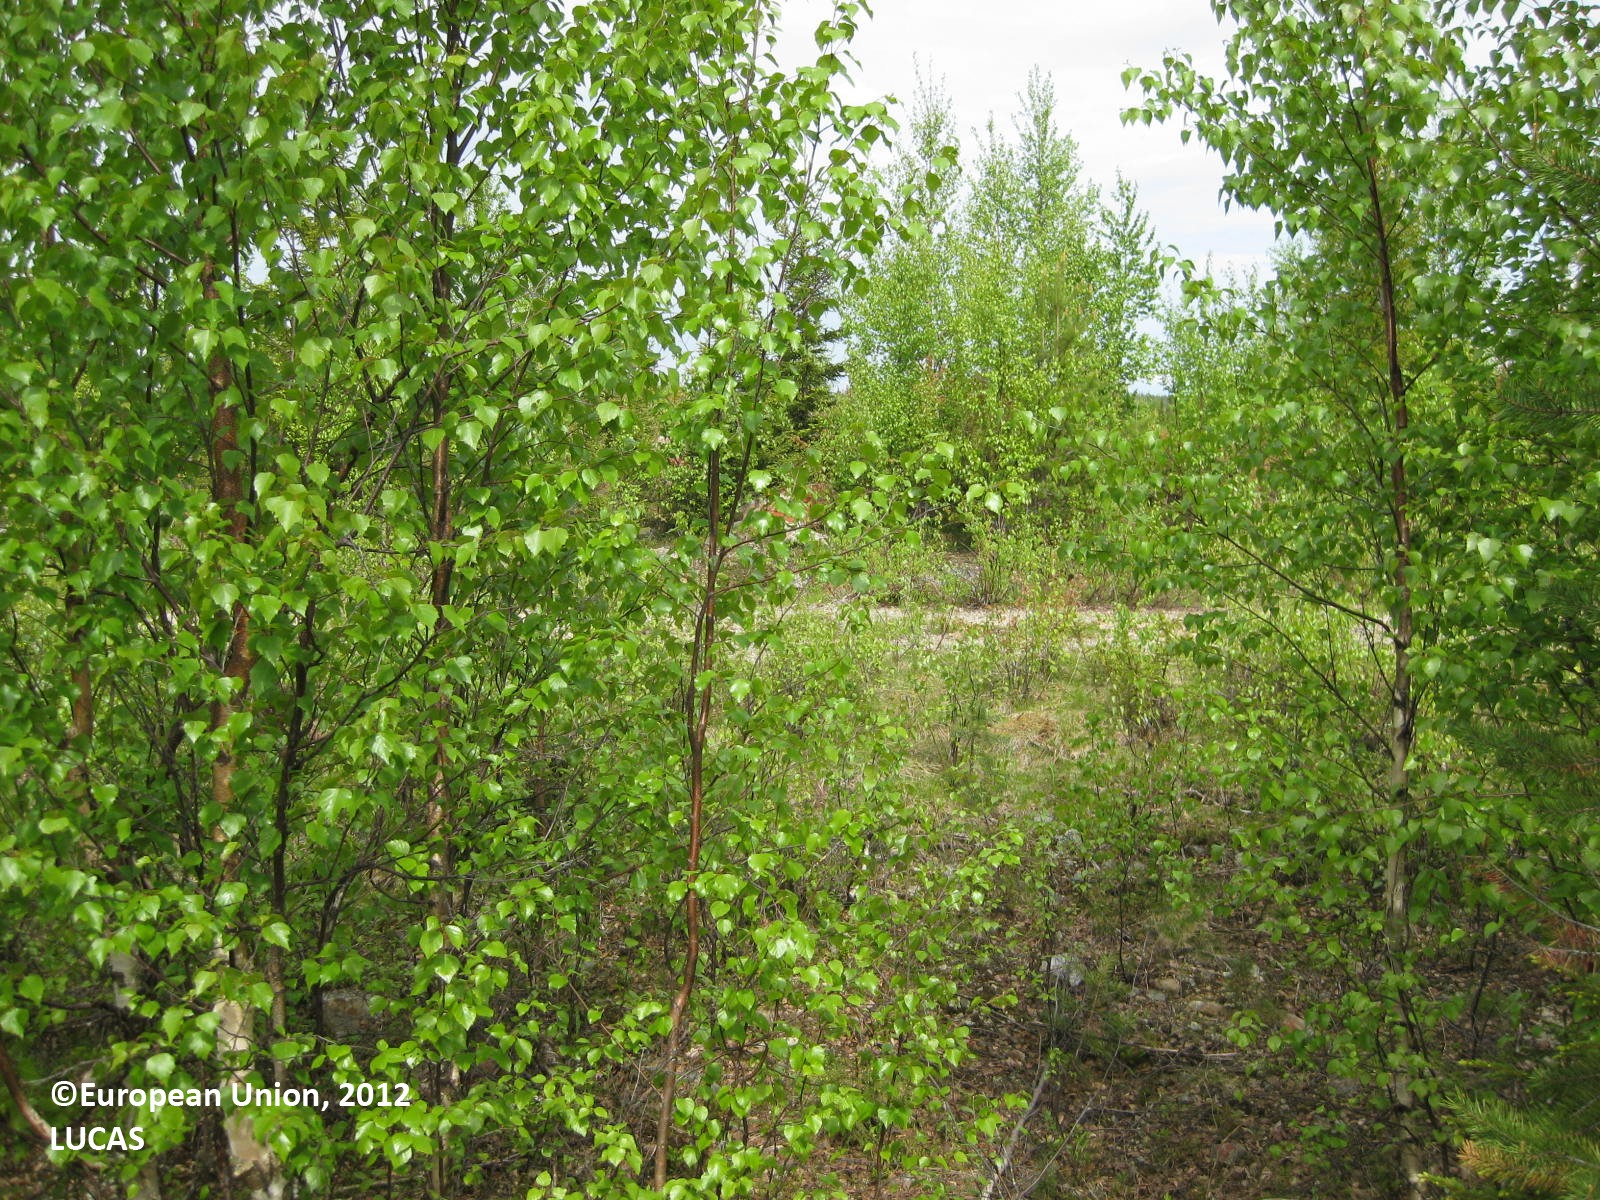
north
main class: Woodland
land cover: Broadleaved woodland
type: boreal forest
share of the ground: 50 - 75 %
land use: Forestry
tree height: > 5 m
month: June
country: FI
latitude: 65.1894
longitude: 28.9118
